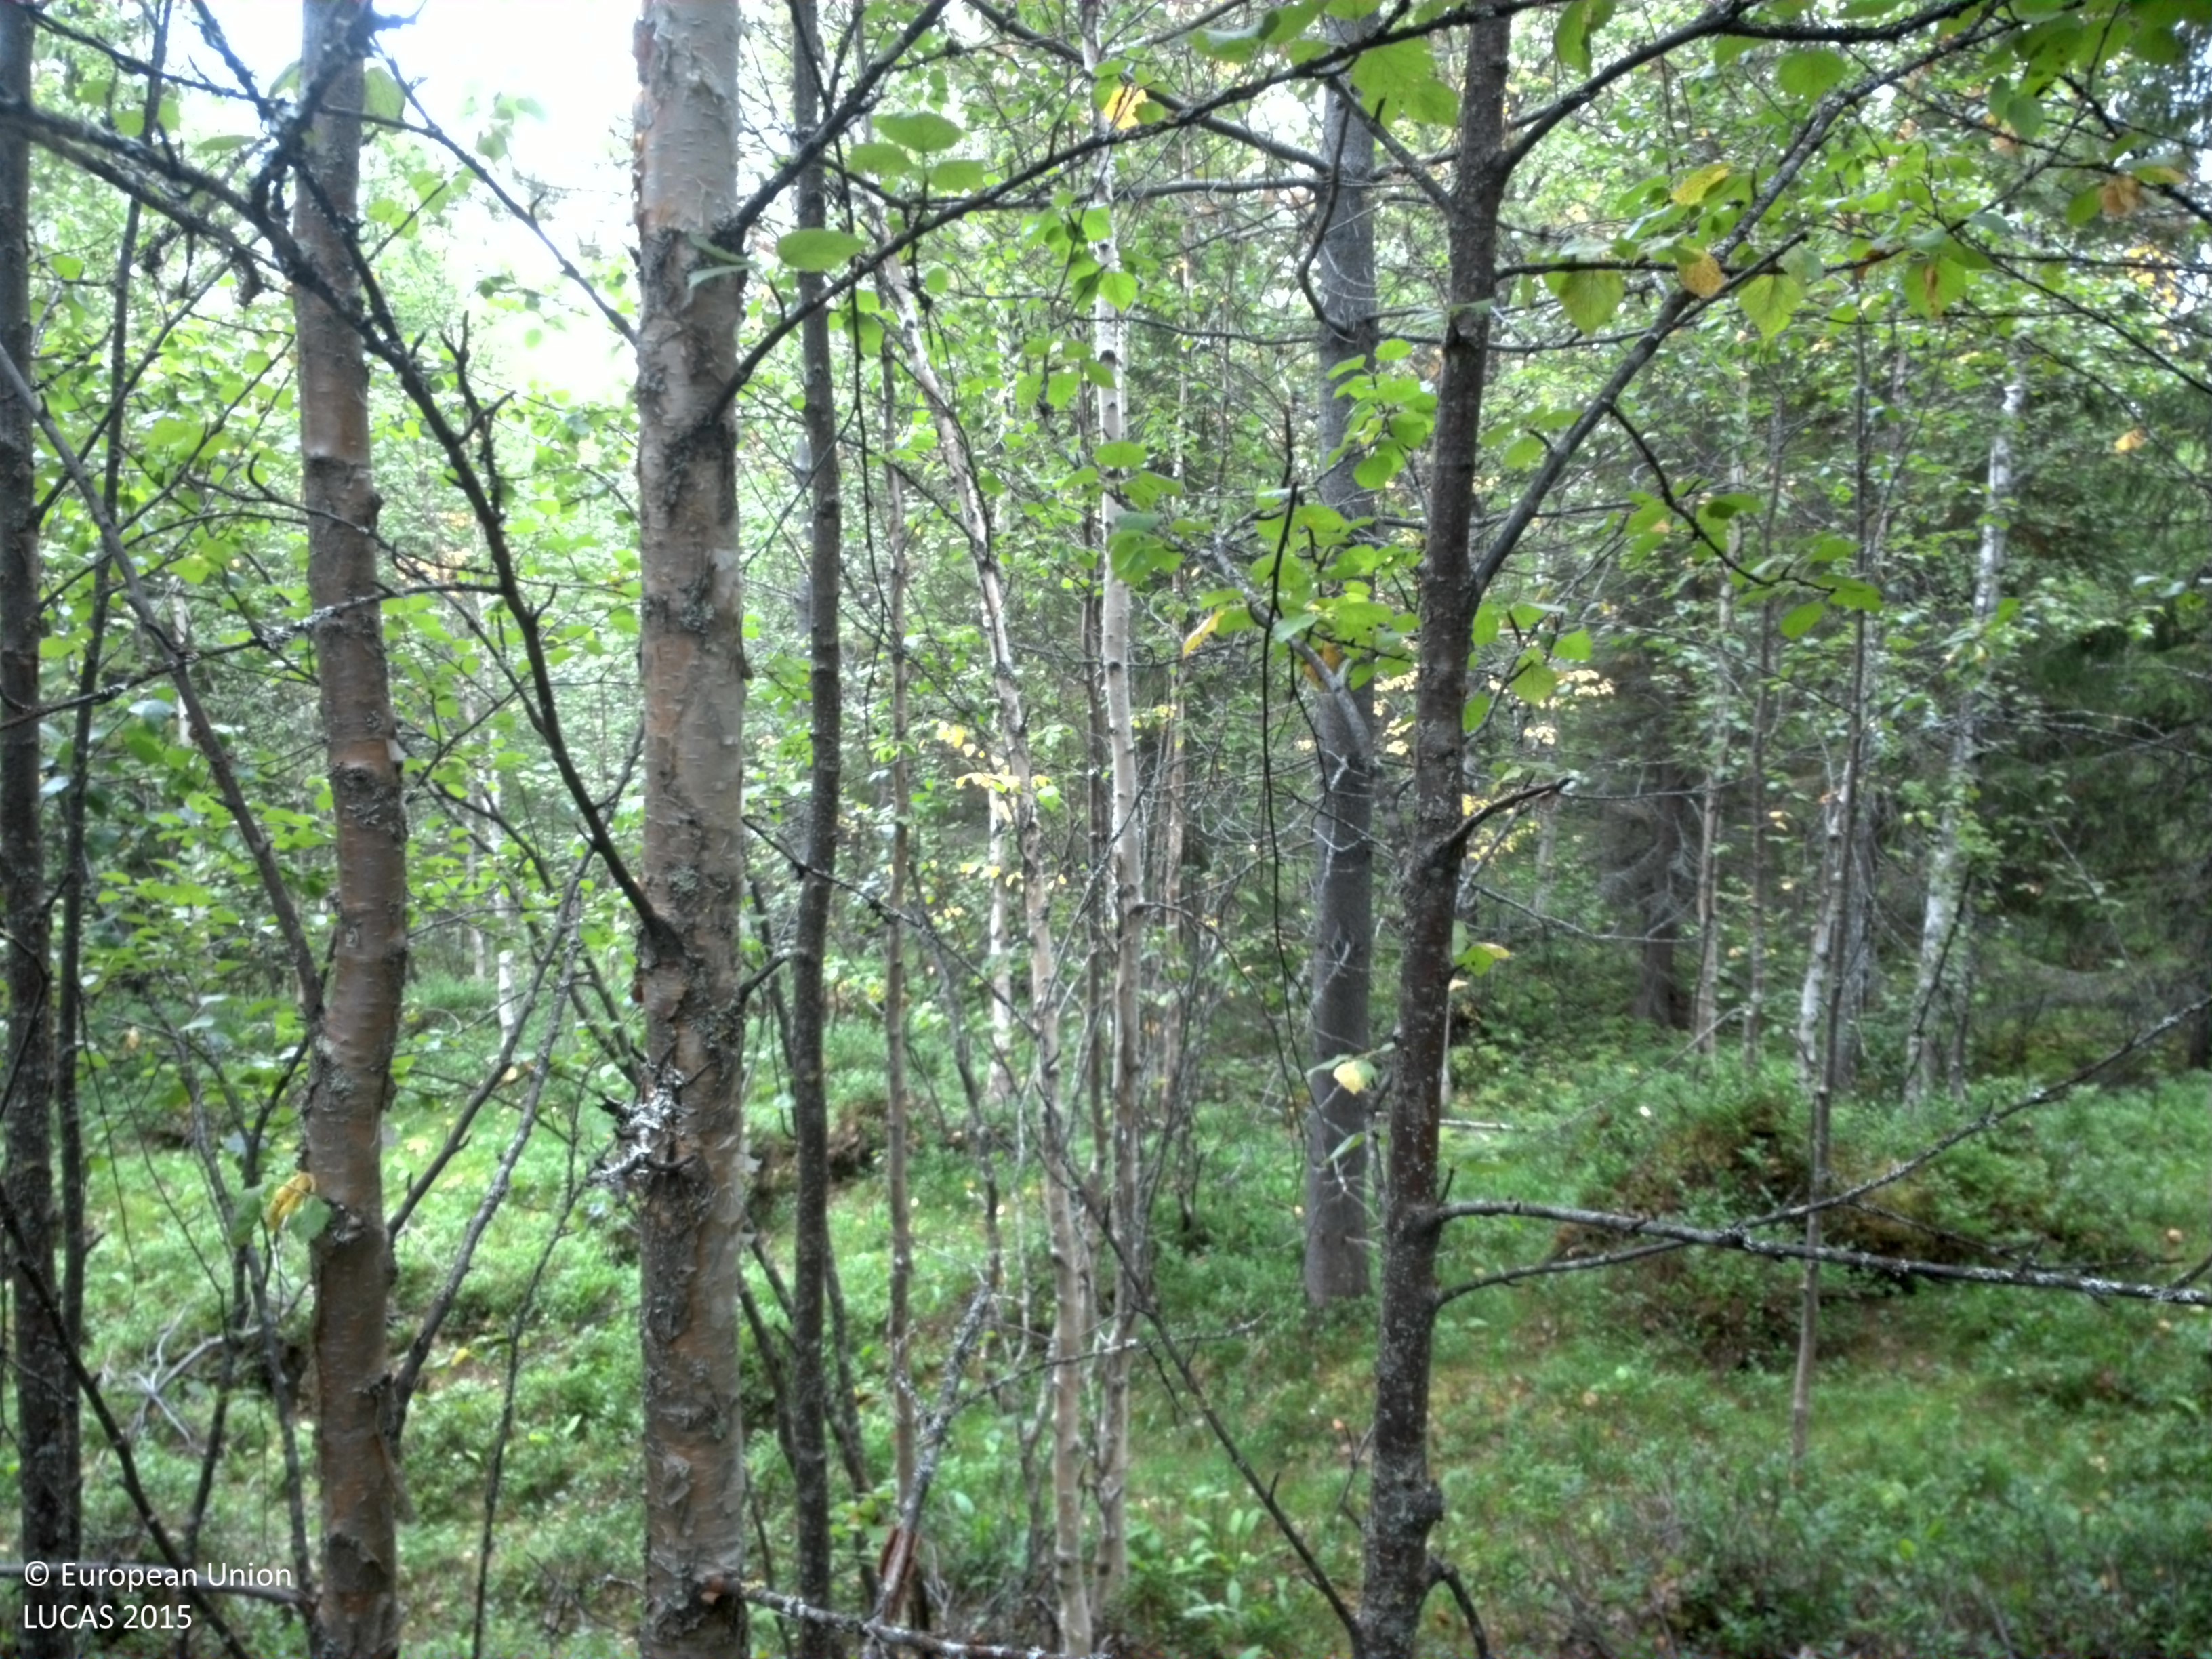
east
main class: Woodland
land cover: Other mixed woodland
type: exotic forest
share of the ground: 50 - 75 %
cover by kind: coniferous forest trees 30 %, broadleaved forest trees 30 %, shrubs 25 %, herbaceous plants 15 %
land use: Forestry
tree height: > 5 m
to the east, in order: Other mixed woodland; Spruce dominated mixed woodland; Shruby margins; Ditches and canals; Shruby margins; Paved roads, cycling and walking lanes; Shruby margins; Spruce dominated mixed woodland; Ditches and canals; Spruce dominated mixed woodland; Spruce dominated coniferous woodland
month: August
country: SE
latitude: 64.8356
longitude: 16.7312
